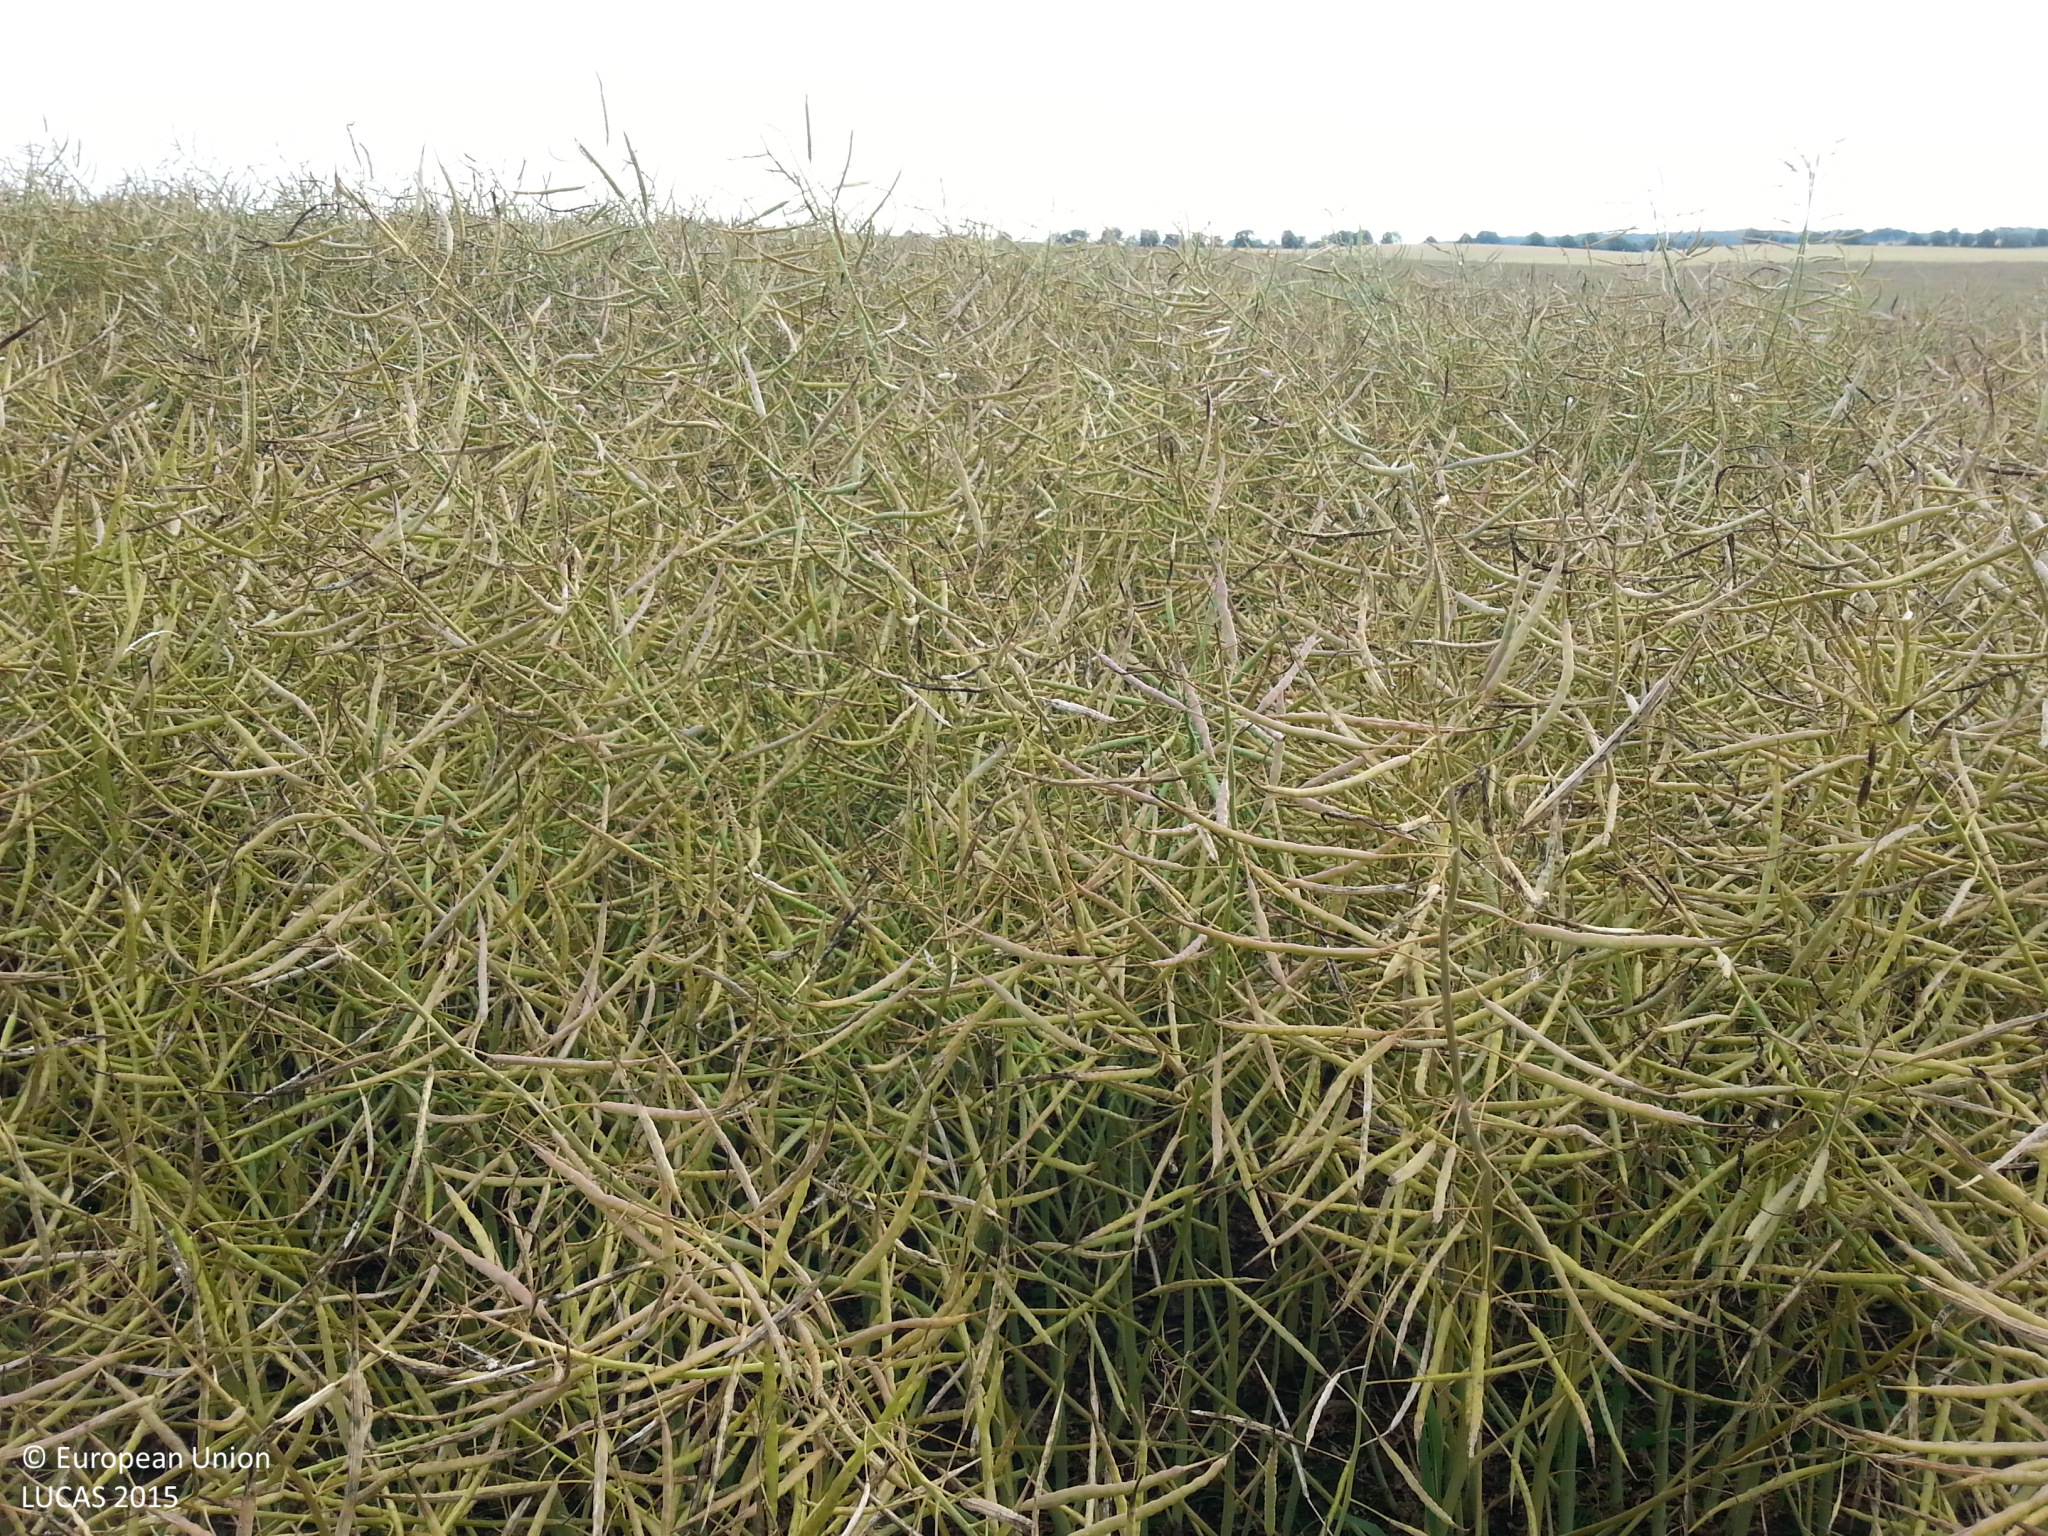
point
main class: Cropland
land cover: Rape and turnip rape
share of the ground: > 75 %
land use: Agriculture (excluding fallow land and kitchen gardens)
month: July
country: DE
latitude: 53.9717
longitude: 11.1428
